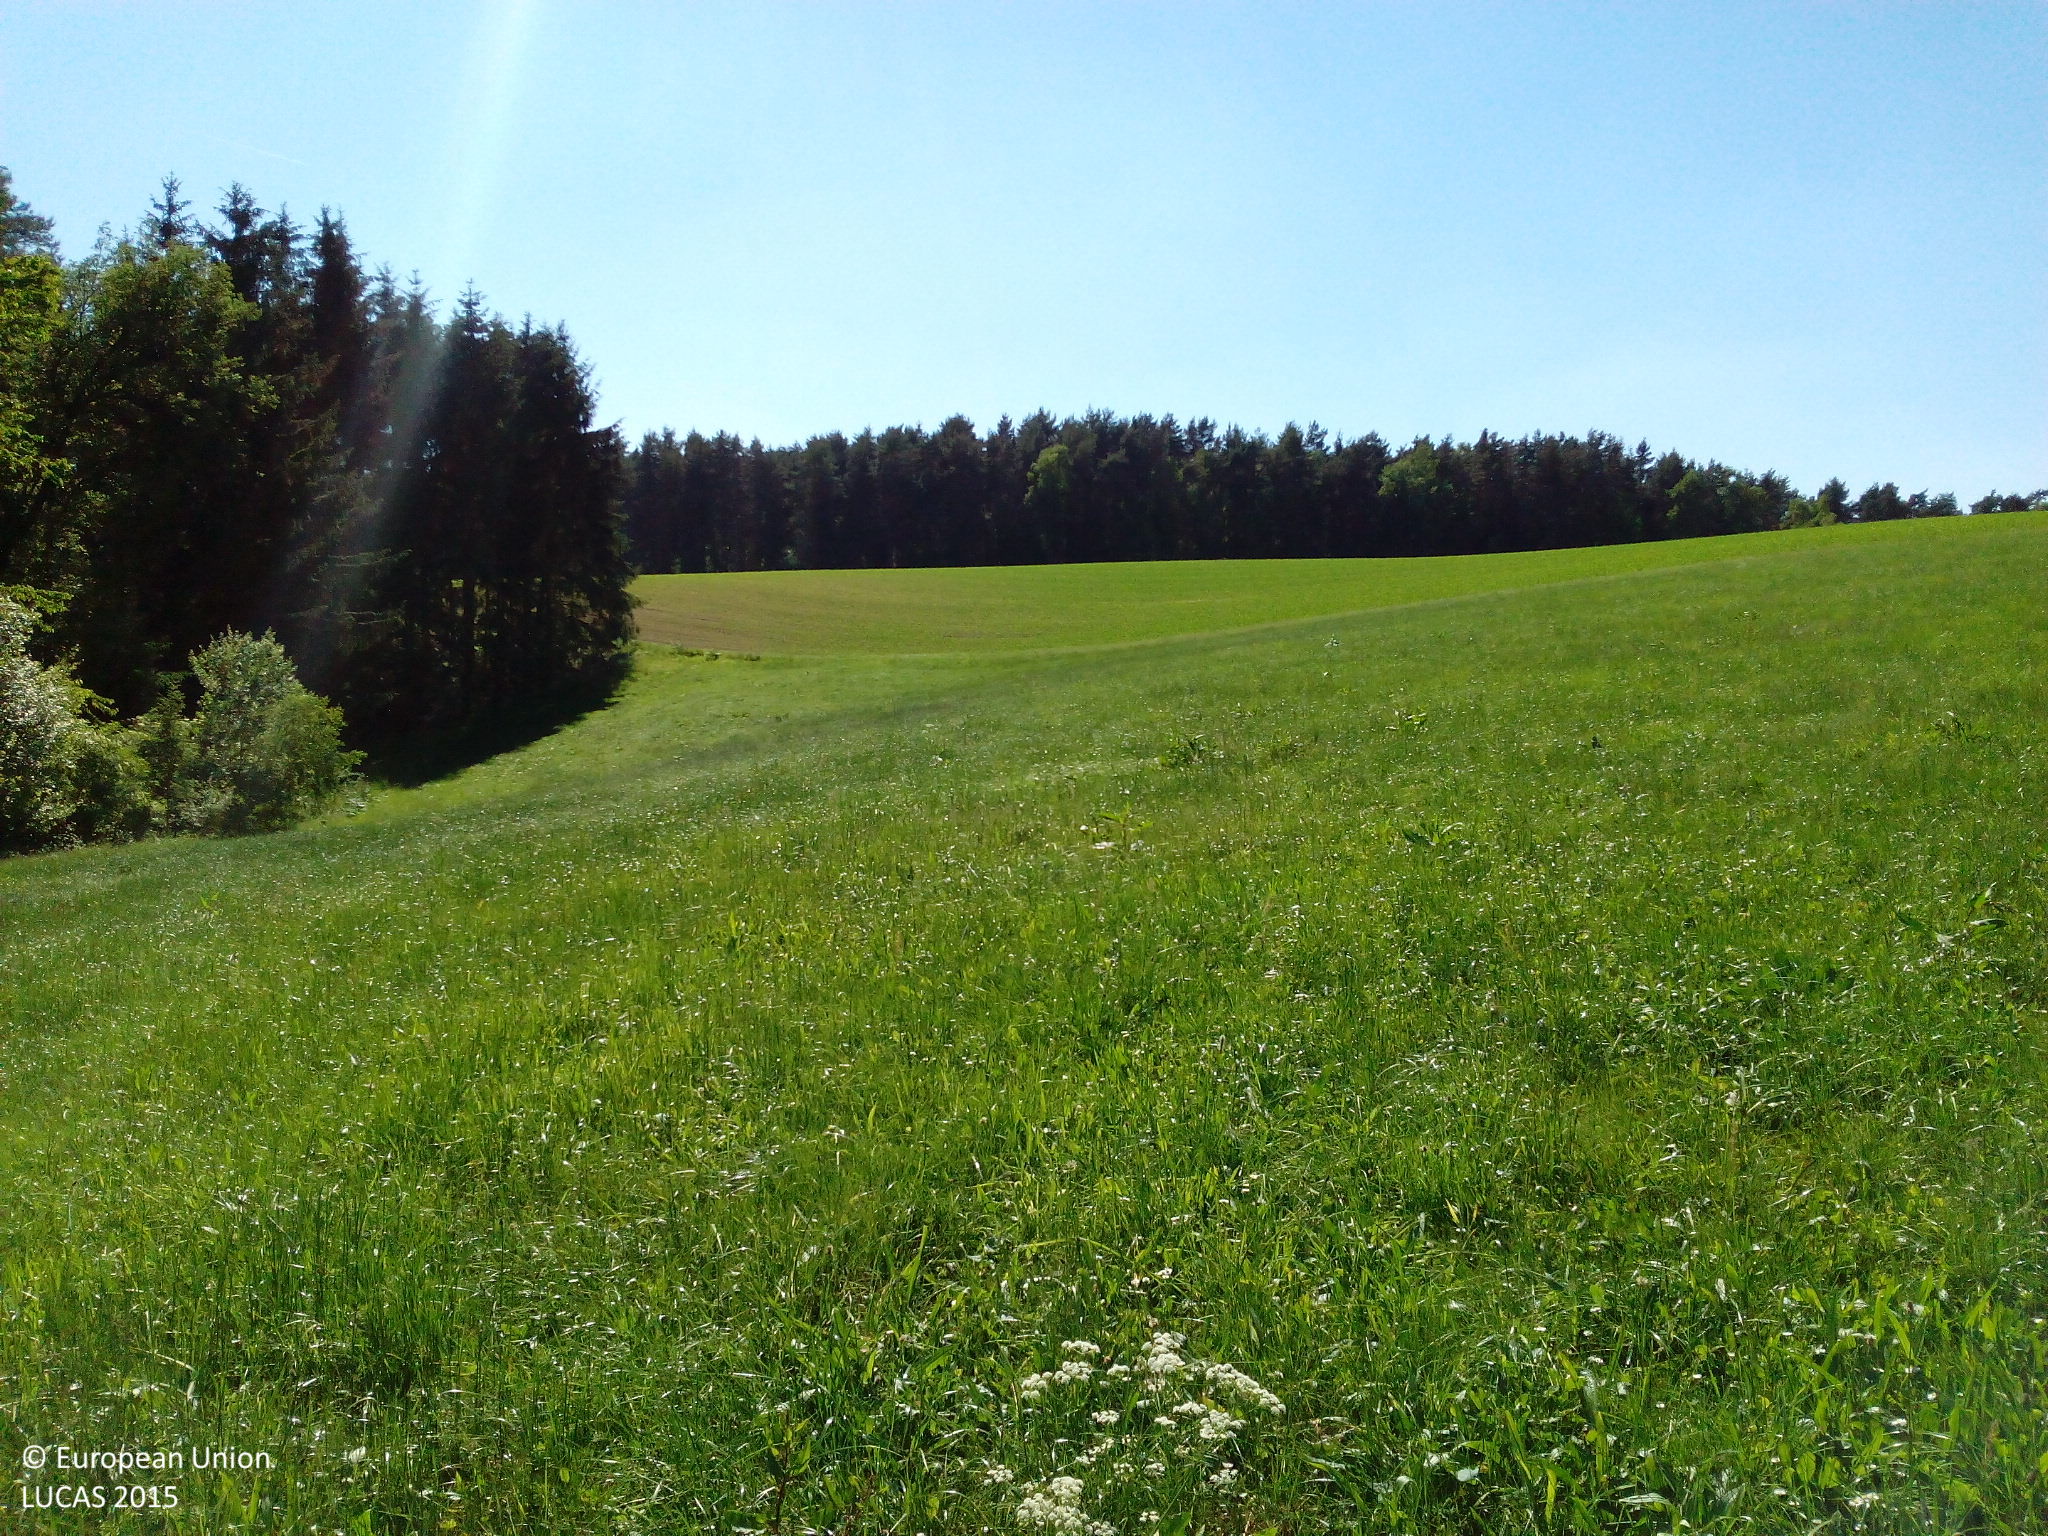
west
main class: Grassland
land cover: Grassland without tree/shrub cover
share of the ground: > 75 %
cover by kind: herbaceous plants 100 %
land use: Agriculture (excluding fallow land and kitchen gardens)
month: June
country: DE
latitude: 49.2767
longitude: 12.4324
